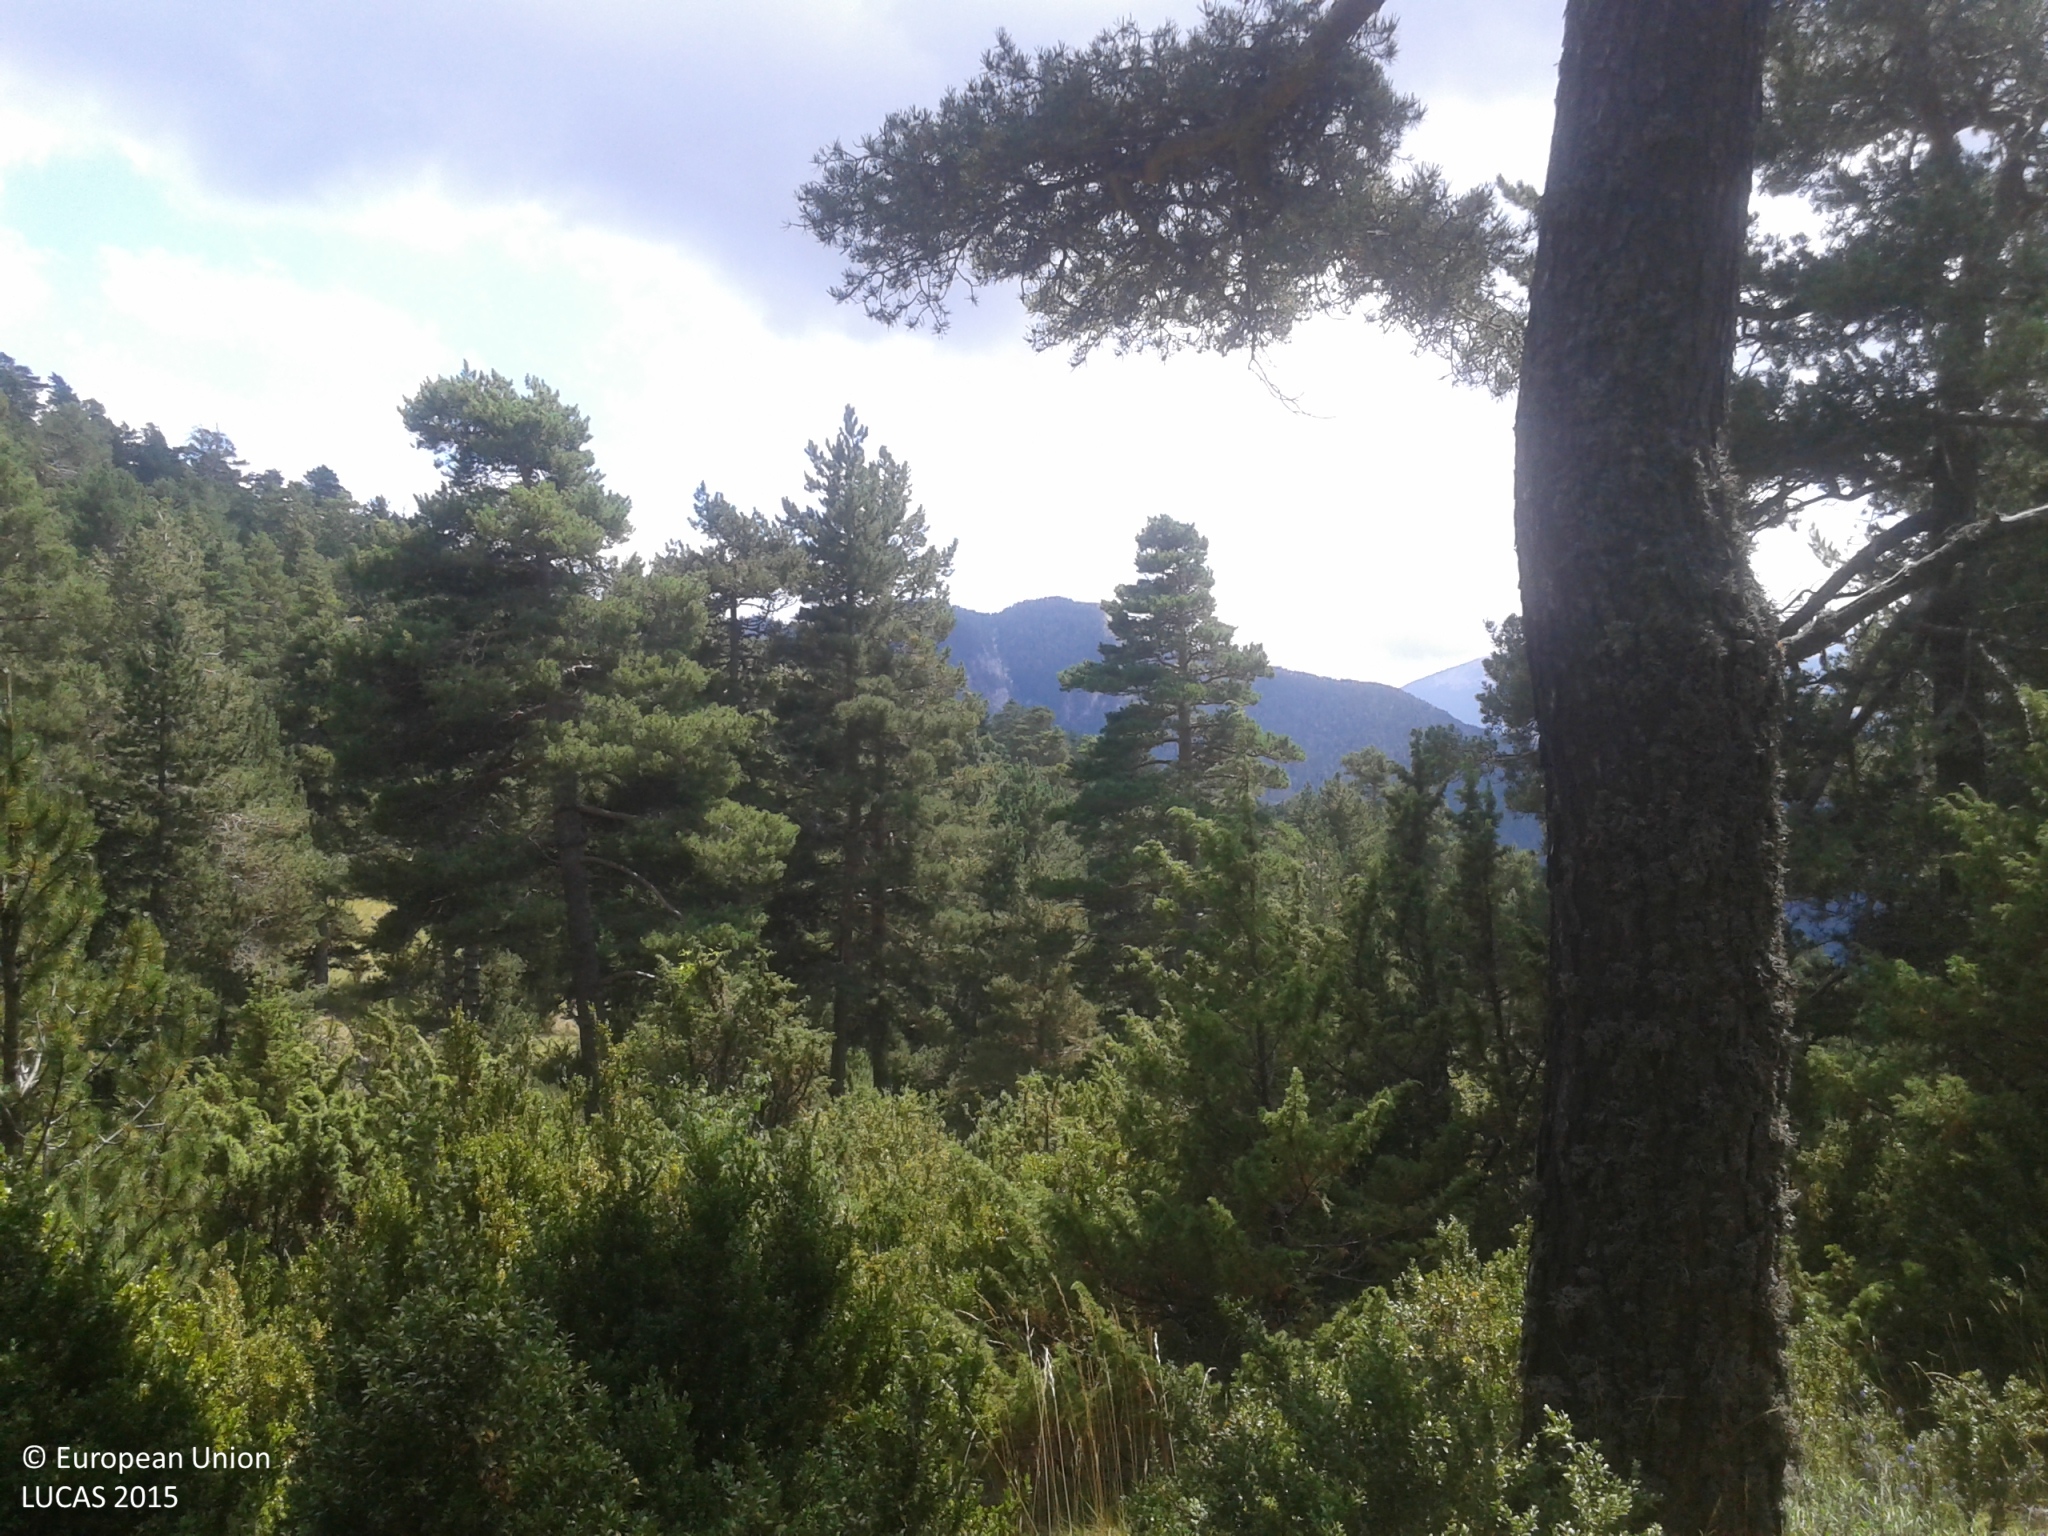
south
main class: Woodland
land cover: Pine dominated coniferous woodland
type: alpine coniferous forest
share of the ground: 25 - 50 %
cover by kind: shrubs 40 %, coniferous forest trees 30 %, herbaceous plants 30 %
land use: Semi-natural and natural areas not in use
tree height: > 5 m
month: July
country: ES
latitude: 42.2312
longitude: 1.5901
